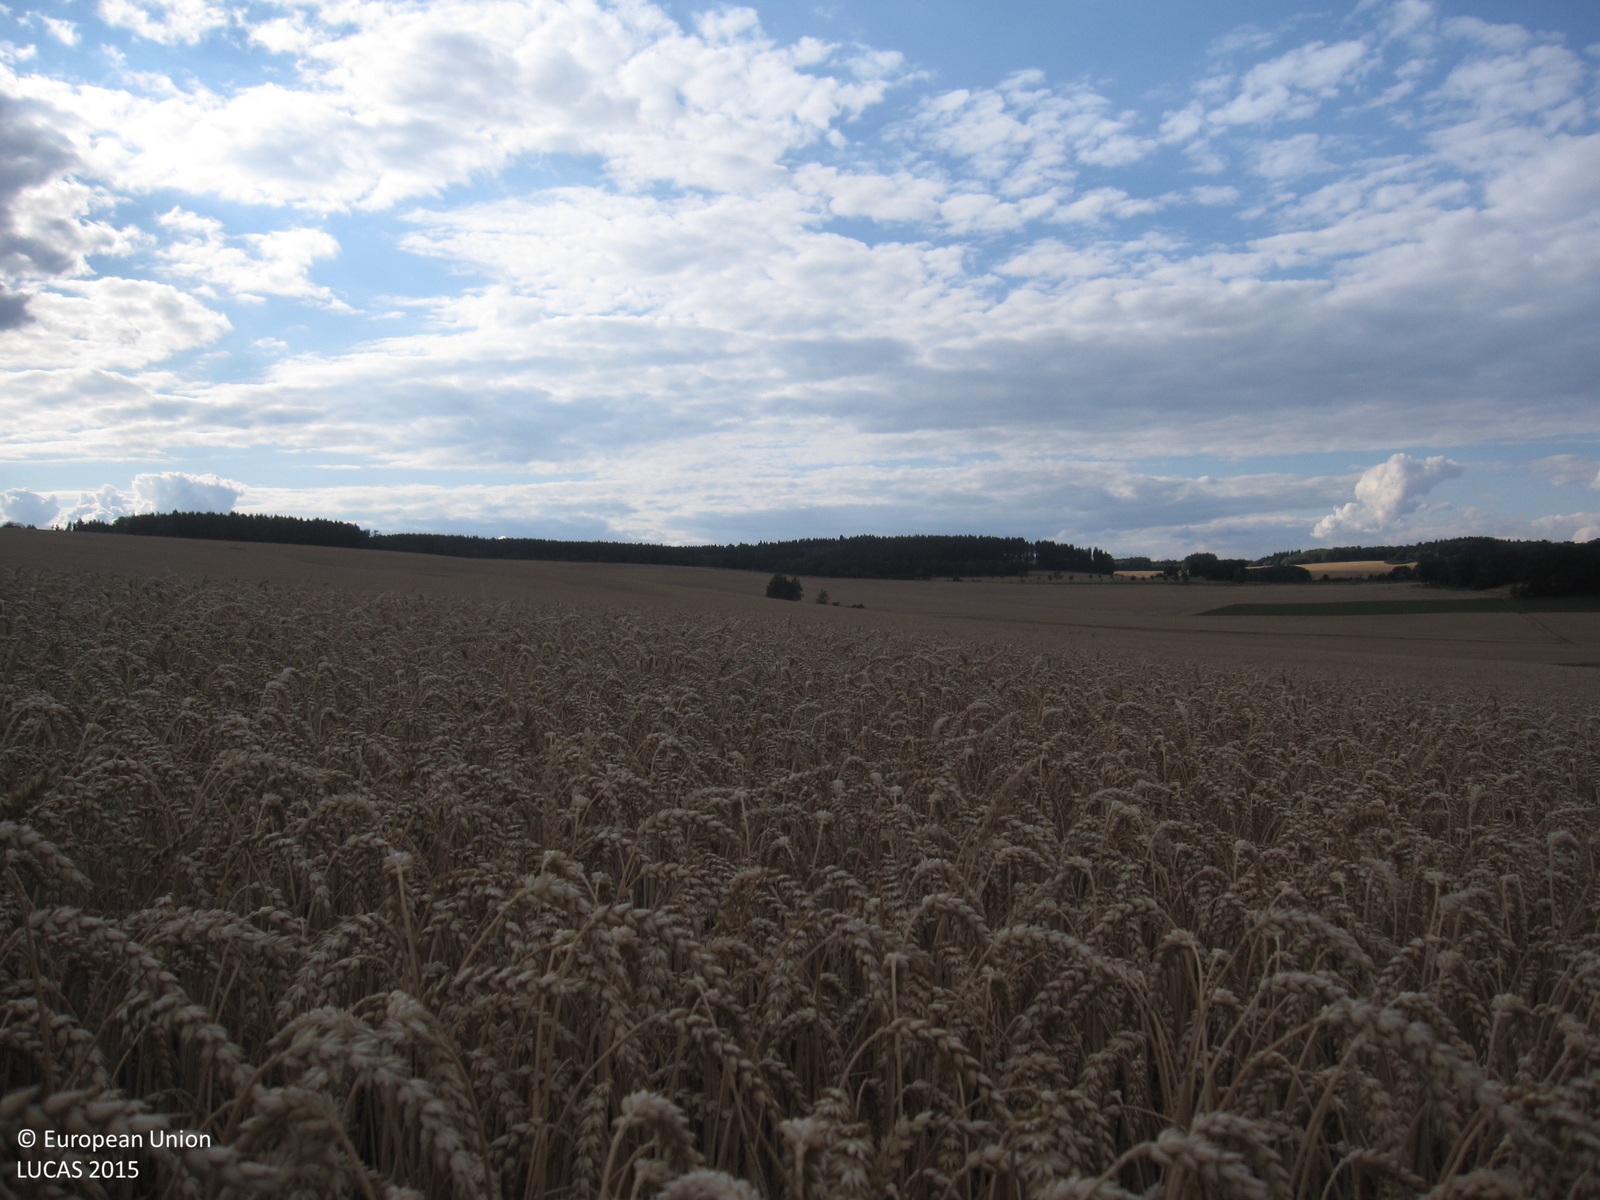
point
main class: Cropland
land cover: Common wheat
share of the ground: > 75 %
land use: Agriculture (excluding fallow land and kitchen gardens)
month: July
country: DE
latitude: 50.4727
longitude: 11.9863
